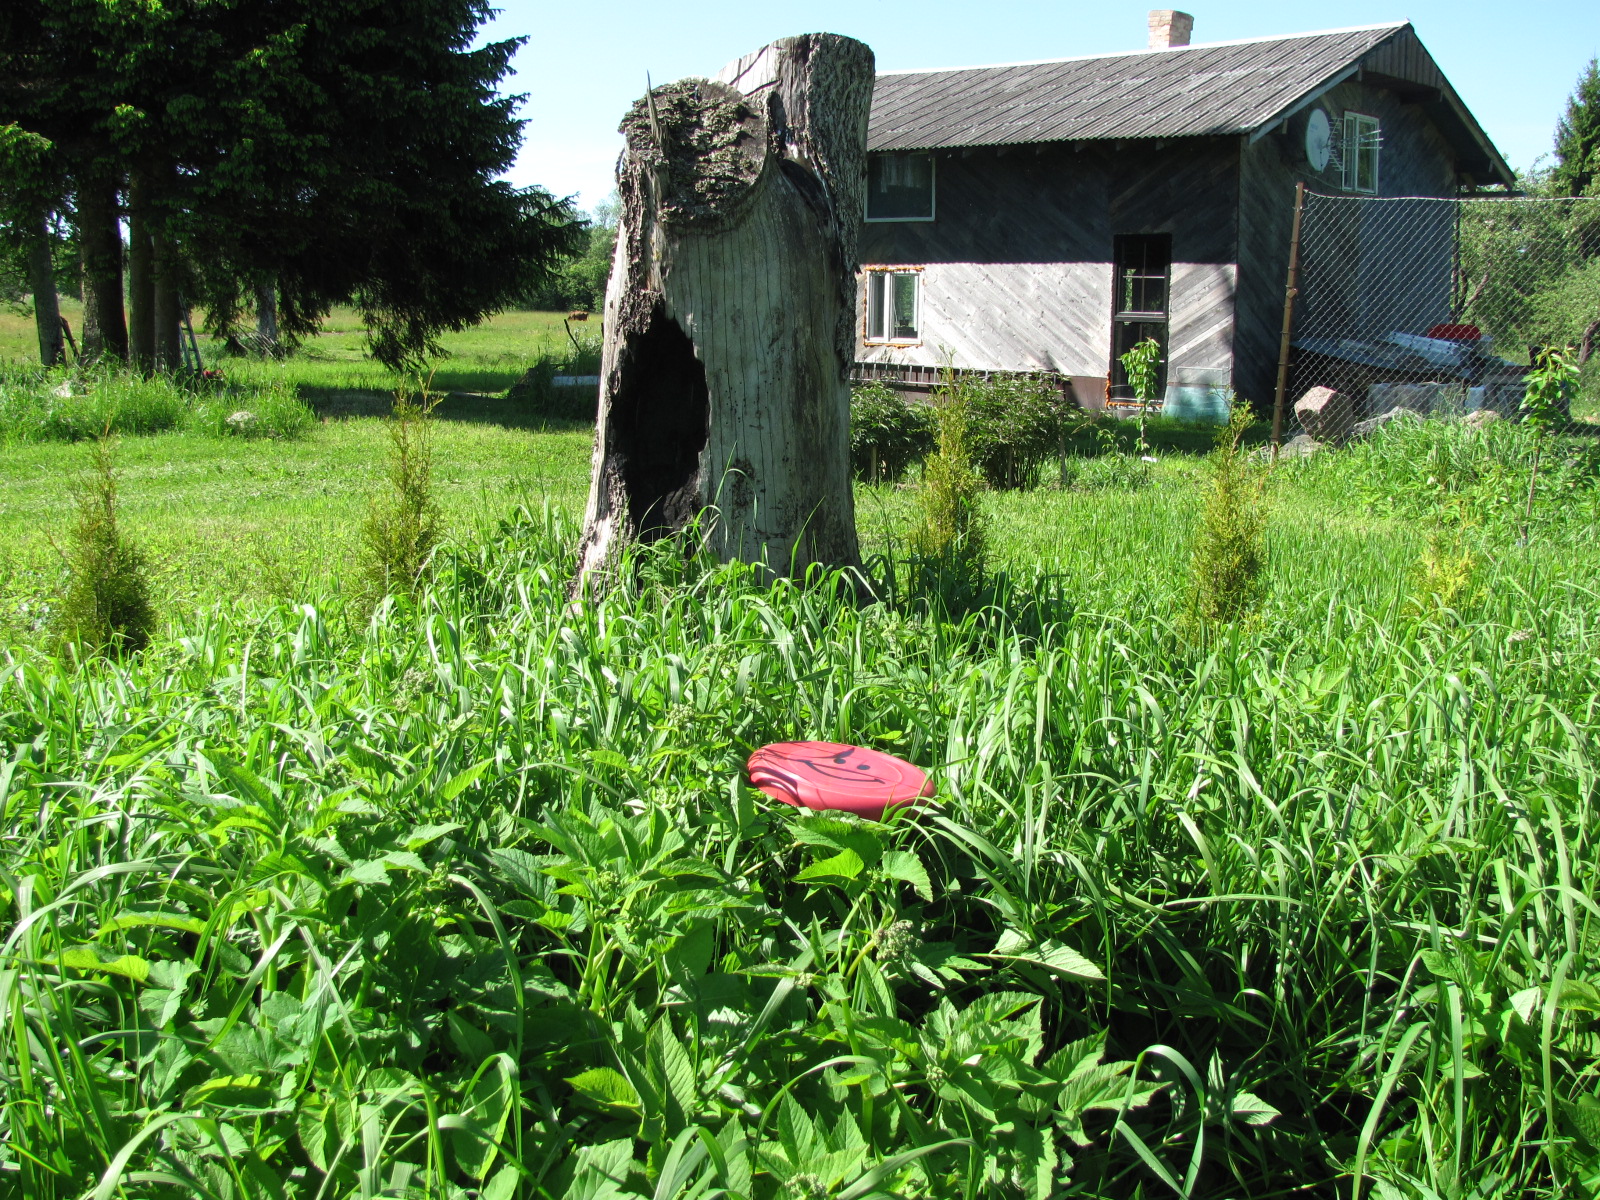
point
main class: Grassland
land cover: Grassland without tree/shrub cover
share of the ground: > 75 %
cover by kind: herbaceous plants 100 %
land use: Residential
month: June
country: LV
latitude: 56.5493
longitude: 24.3250
